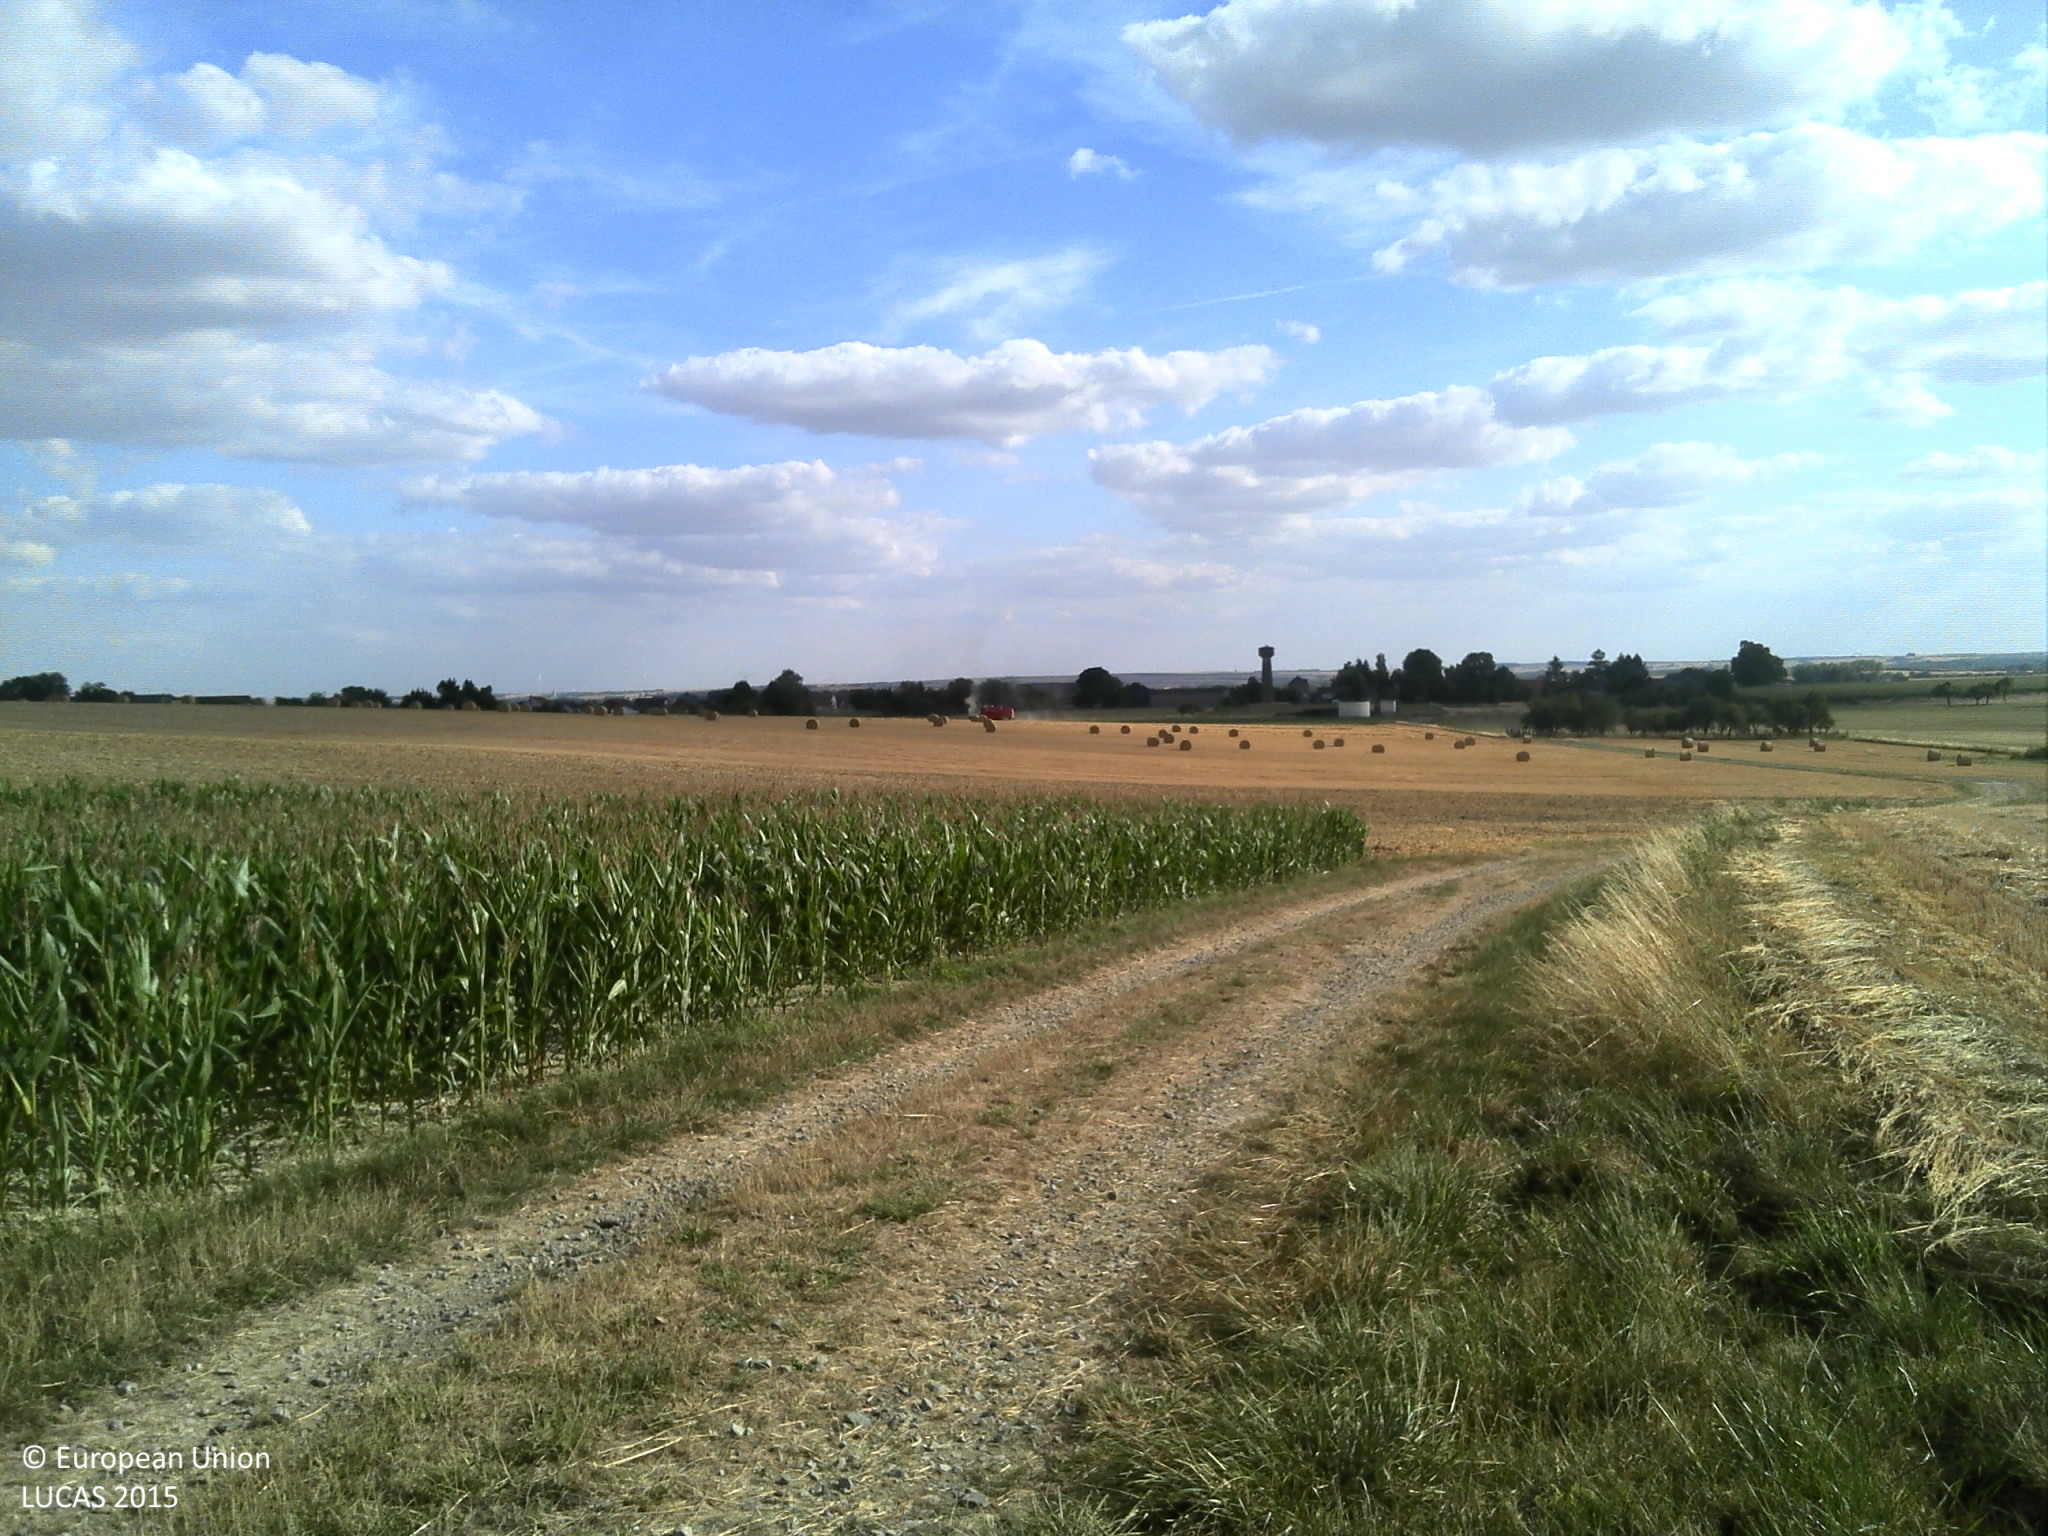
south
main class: Cropland
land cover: Common wheat
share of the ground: > 75 %
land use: Agriculture (excluding fallow land and kitchen gardens)
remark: Harvested field
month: July
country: FR
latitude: 49.5459
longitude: 4.4816
